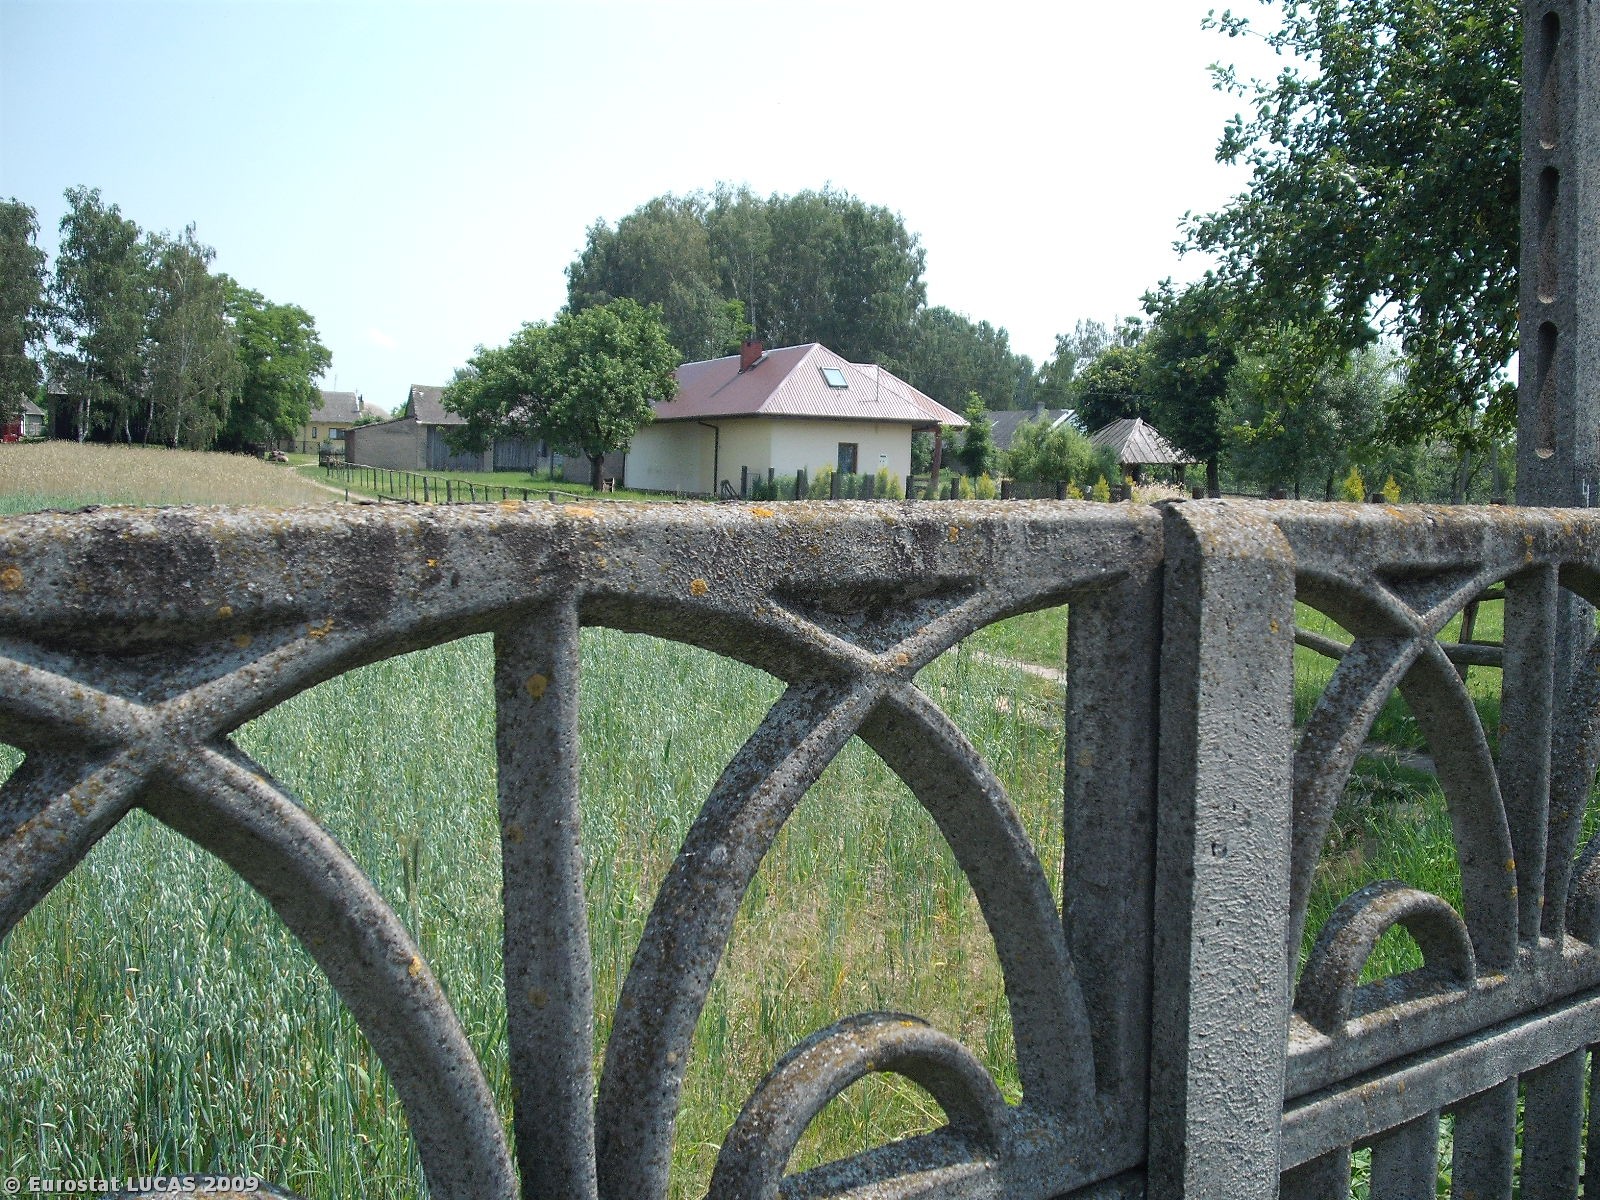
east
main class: Grassland
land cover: Grassland without tree/shrub cover
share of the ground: > 75 %
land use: Residential
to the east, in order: Grassland without tree/shrub cover; Artificial constructions in urban areas
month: July
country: PL
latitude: 51.4696
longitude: 20.5625
